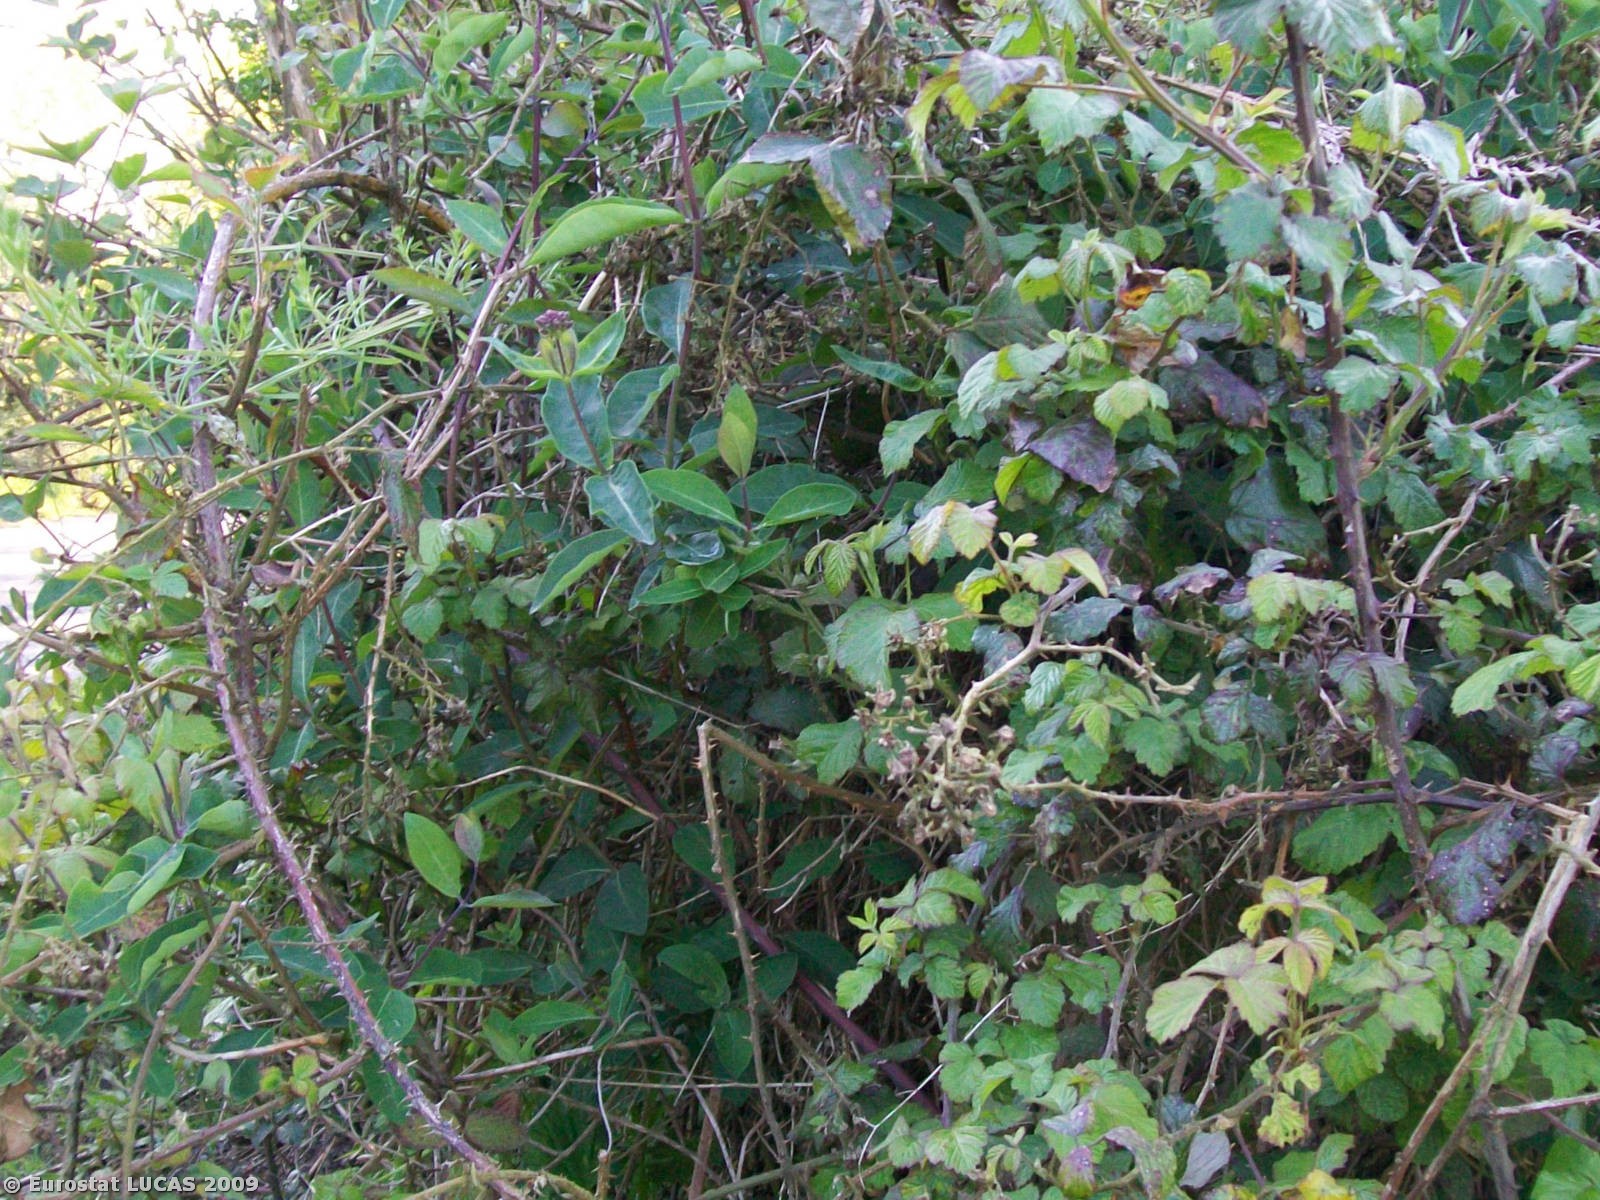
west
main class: Grassland
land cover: Grassland without tree/shrub cover
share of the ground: > 75 %
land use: Agriculture (excluding fallow land and kitchen gardens)
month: May
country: IE
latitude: 52.0692
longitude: -8.2603
